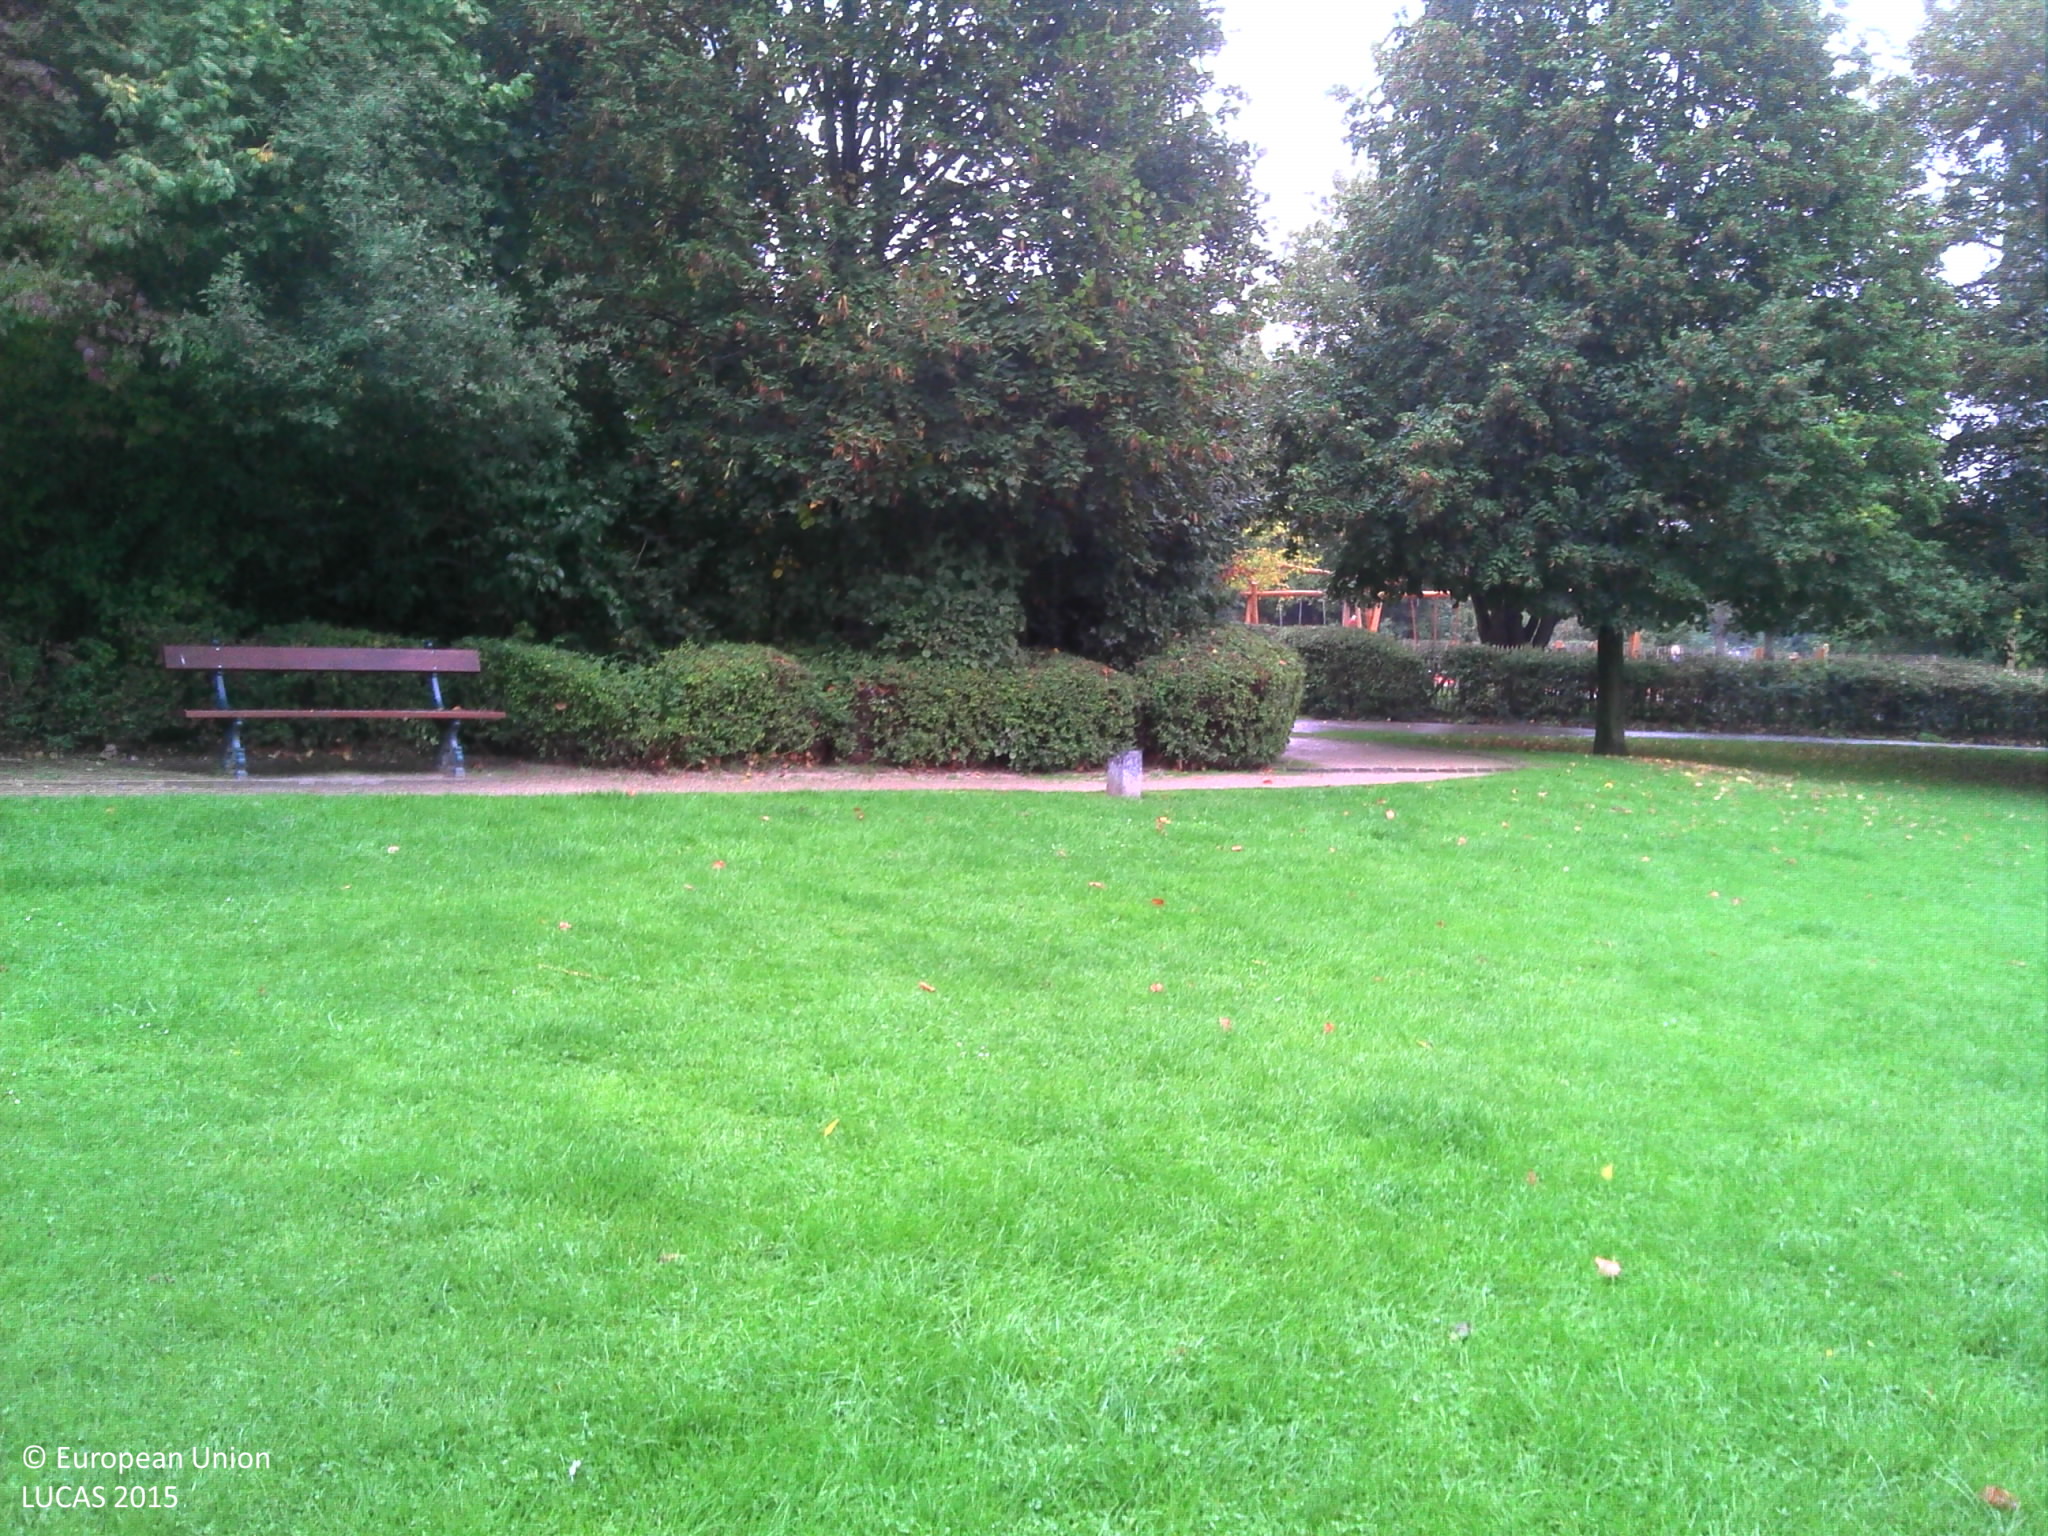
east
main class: Grassland
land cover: Grassland without tree/shrub cover
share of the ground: > 75 %
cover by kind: herbaceous plants 100 %
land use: Amenities, museums, leisure
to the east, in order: Grassland without tree/shrub cover; Artificial constructions in urban areas
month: October
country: BE
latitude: 50.8528
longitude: 4.2991
